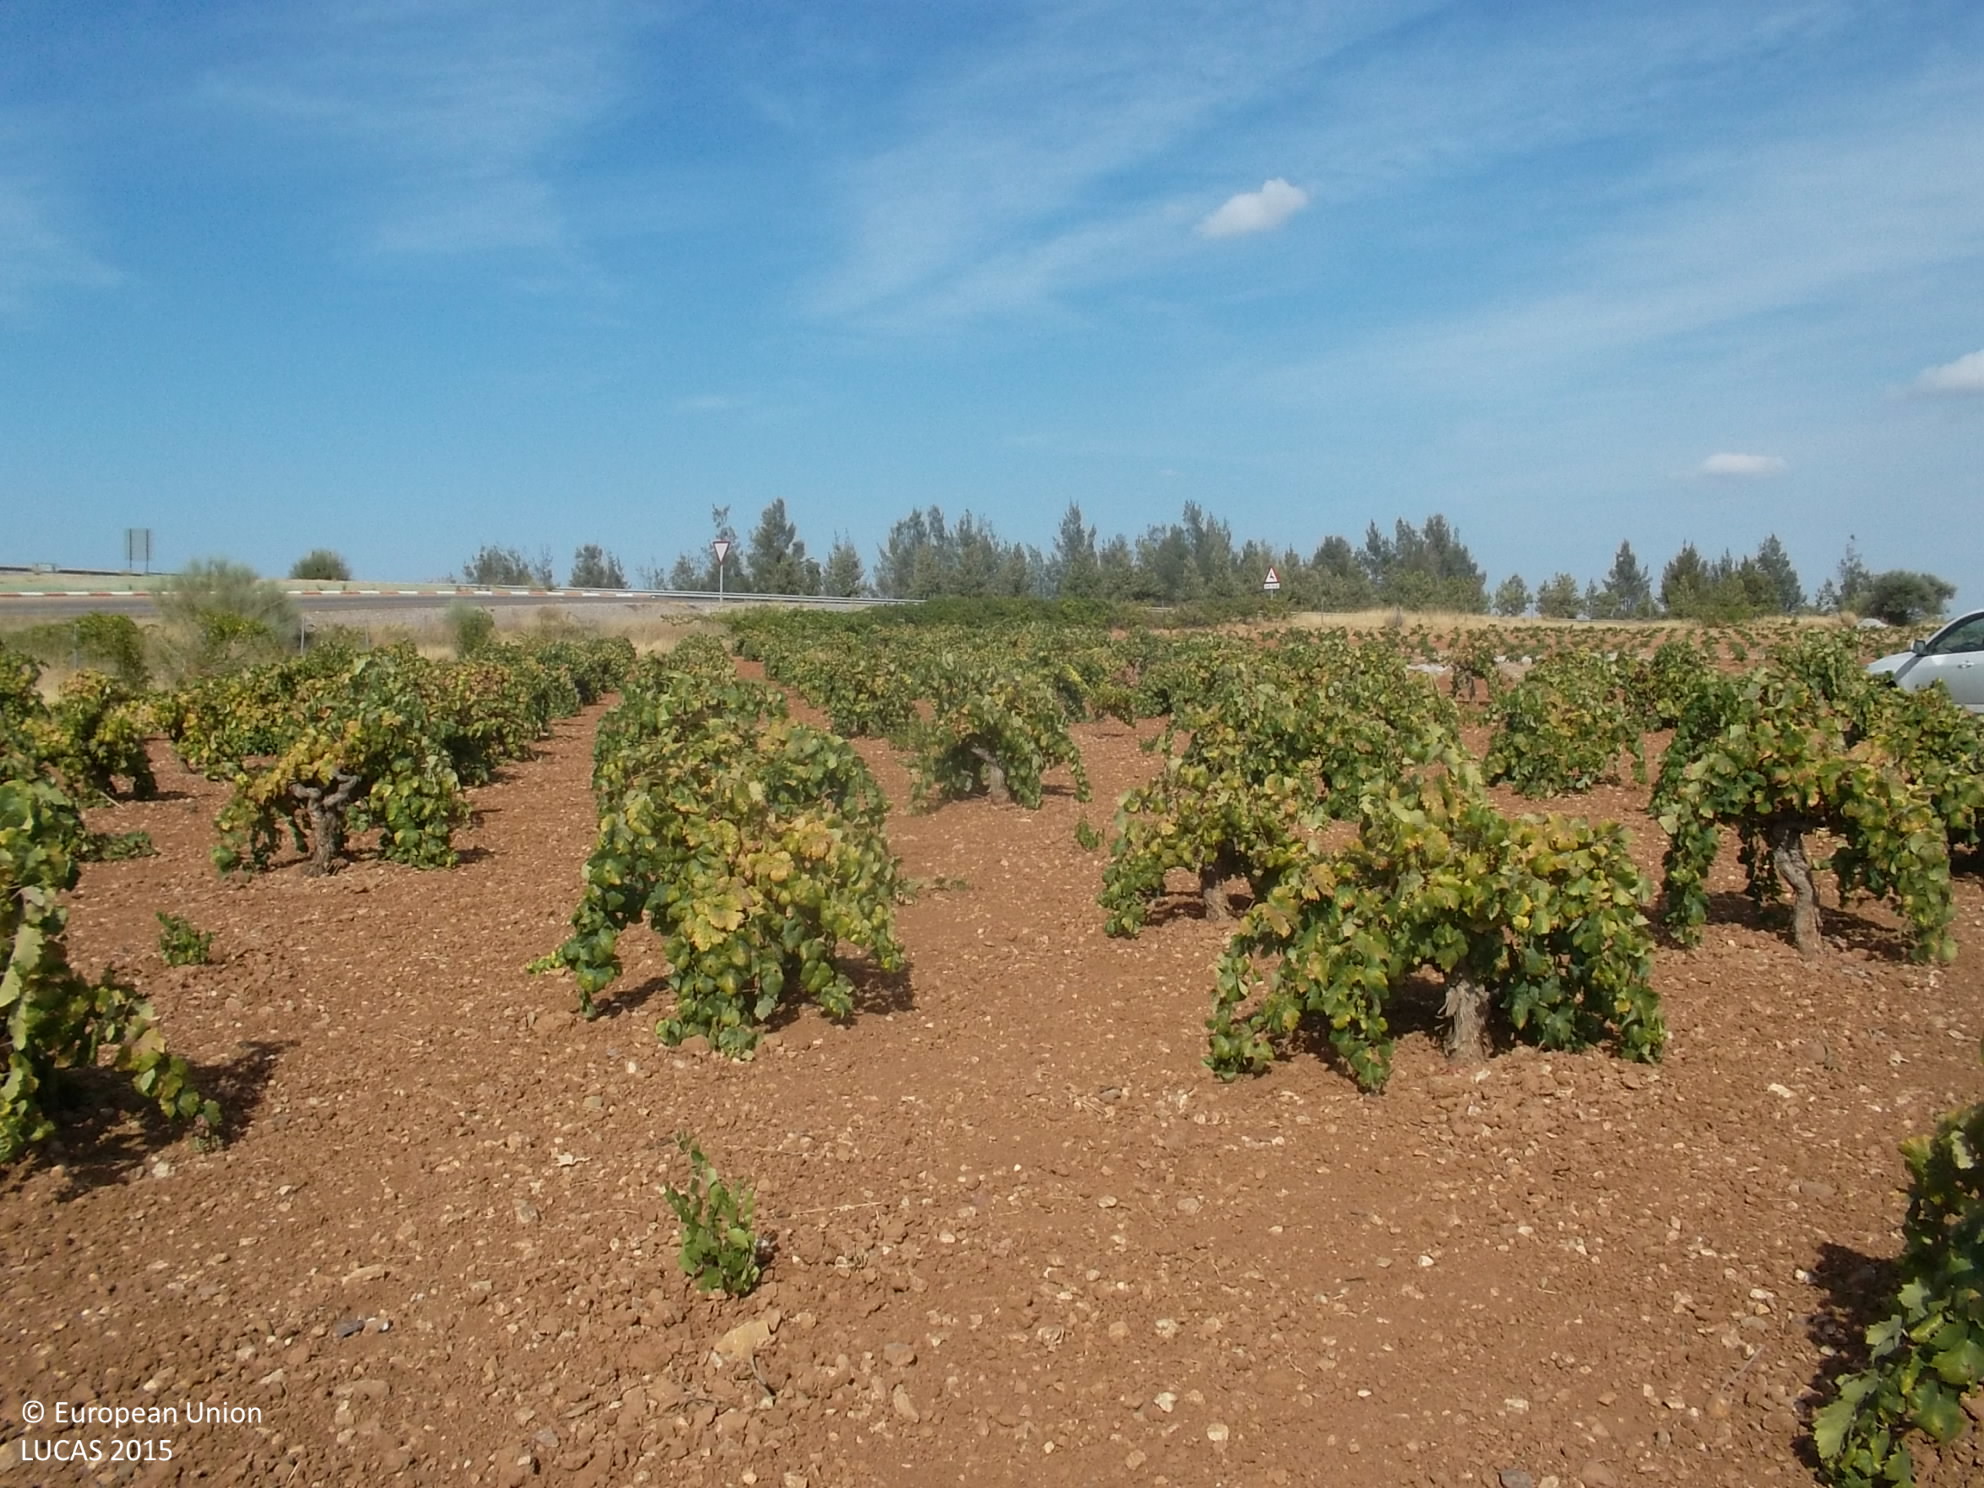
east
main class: Cropland
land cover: Vineyards
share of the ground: 10 - 25 %
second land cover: Other bare soil
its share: > 75 %
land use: Agriculture (excluding fallow land and kitchen gardens)
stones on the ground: < 10 %
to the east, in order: Vineyards; Other bare soil; Tracks; Vineyards; Tracks; Other bare soil; Grassland with sparse tree/shrub cover; Fences; Grass margins; Paved roads, cycling and walking lanes; Grass margins; Olive groves
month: September
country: ES
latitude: 38.4602
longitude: -6.3575
